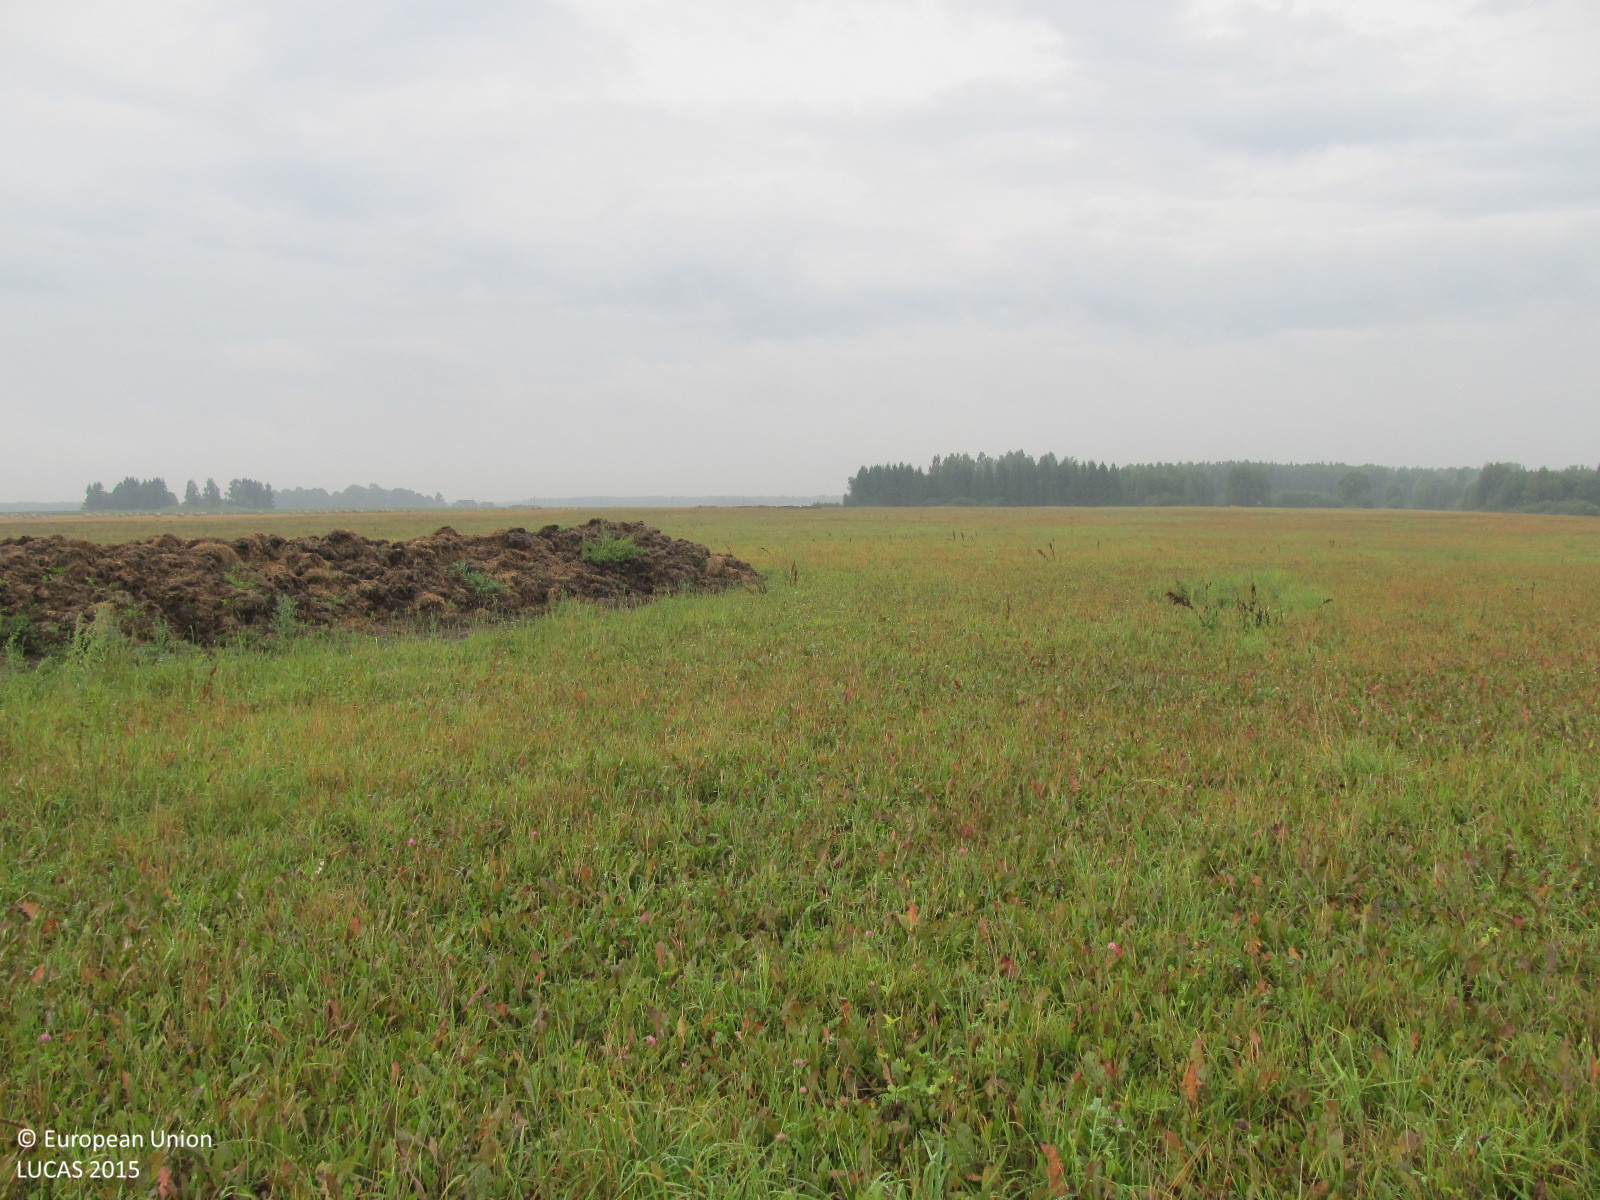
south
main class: Grassland
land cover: Grassland without tree/shrub cover
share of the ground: > 75 %
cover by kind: herbaceous plants 100 %
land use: Agriculture (excluding fallow land and kitchen gardens)
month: September
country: LT
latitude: 56.0747
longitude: 23.1314
